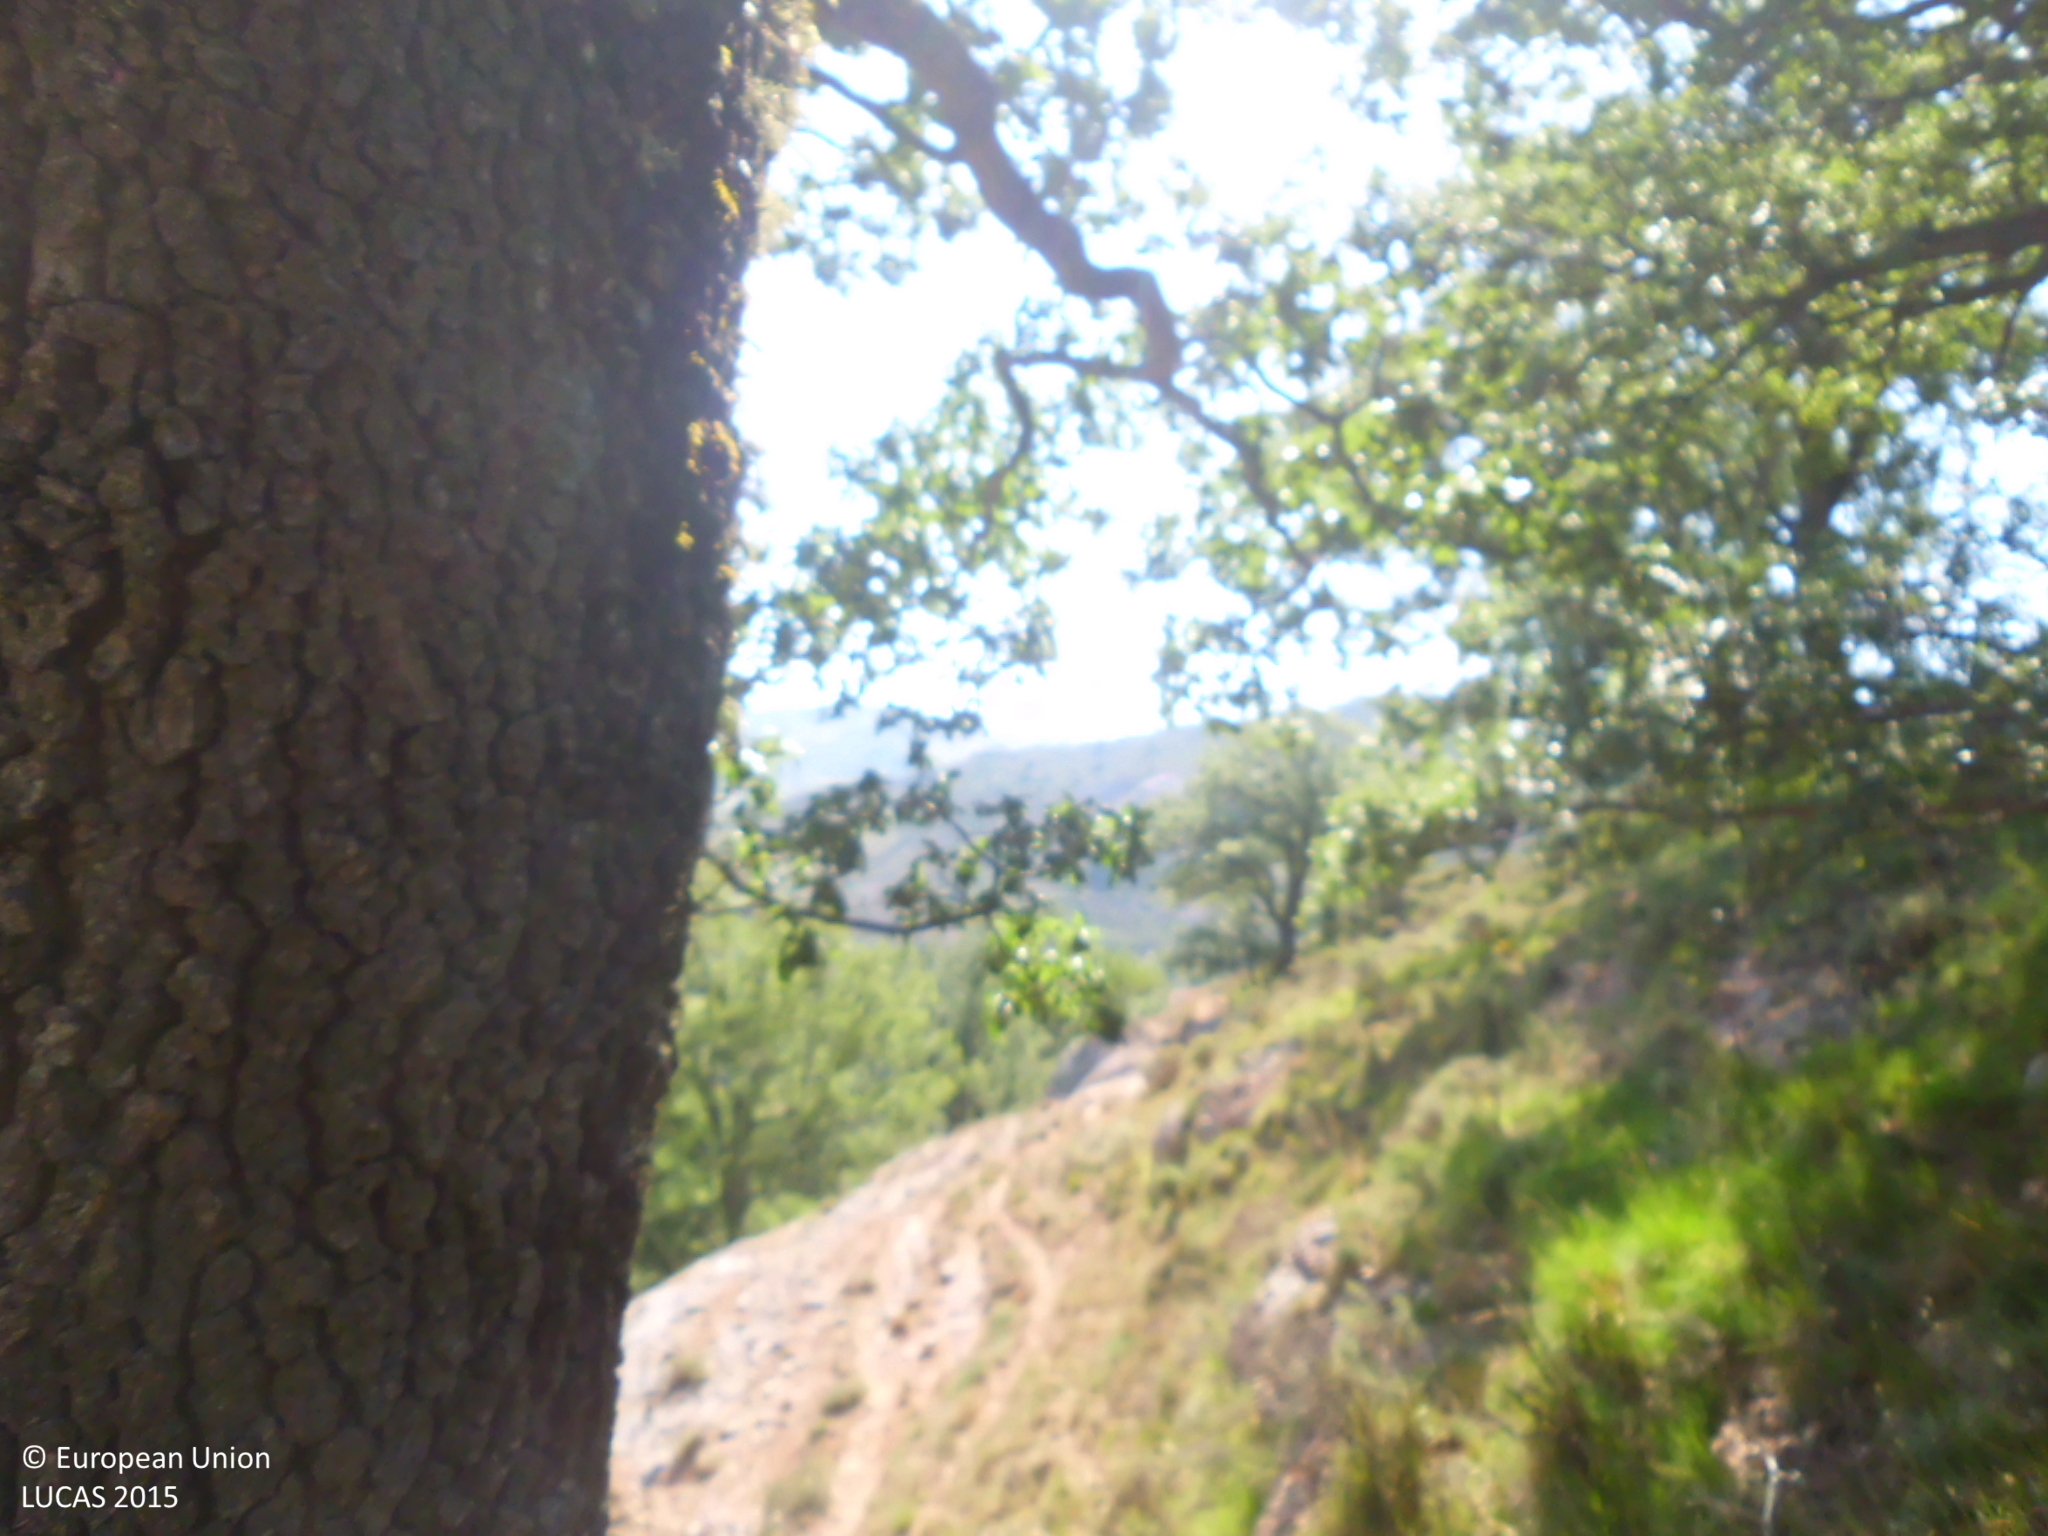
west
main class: Woodland
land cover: Broadleaved woodland
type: acidophilous oak and oak-birch forest
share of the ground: 25 - 50 %
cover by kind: unconsolidated bare surface 35 %, broadleaved forest trees 25 %, herbaceous plants 25 %, consolidated bare surface 10 %, shrubs 5 %
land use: Semi-natural and natural areas not in use
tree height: > 5 m
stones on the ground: 25 - 50 %
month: July
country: ES
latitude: 42.3314
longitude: -3.2210
